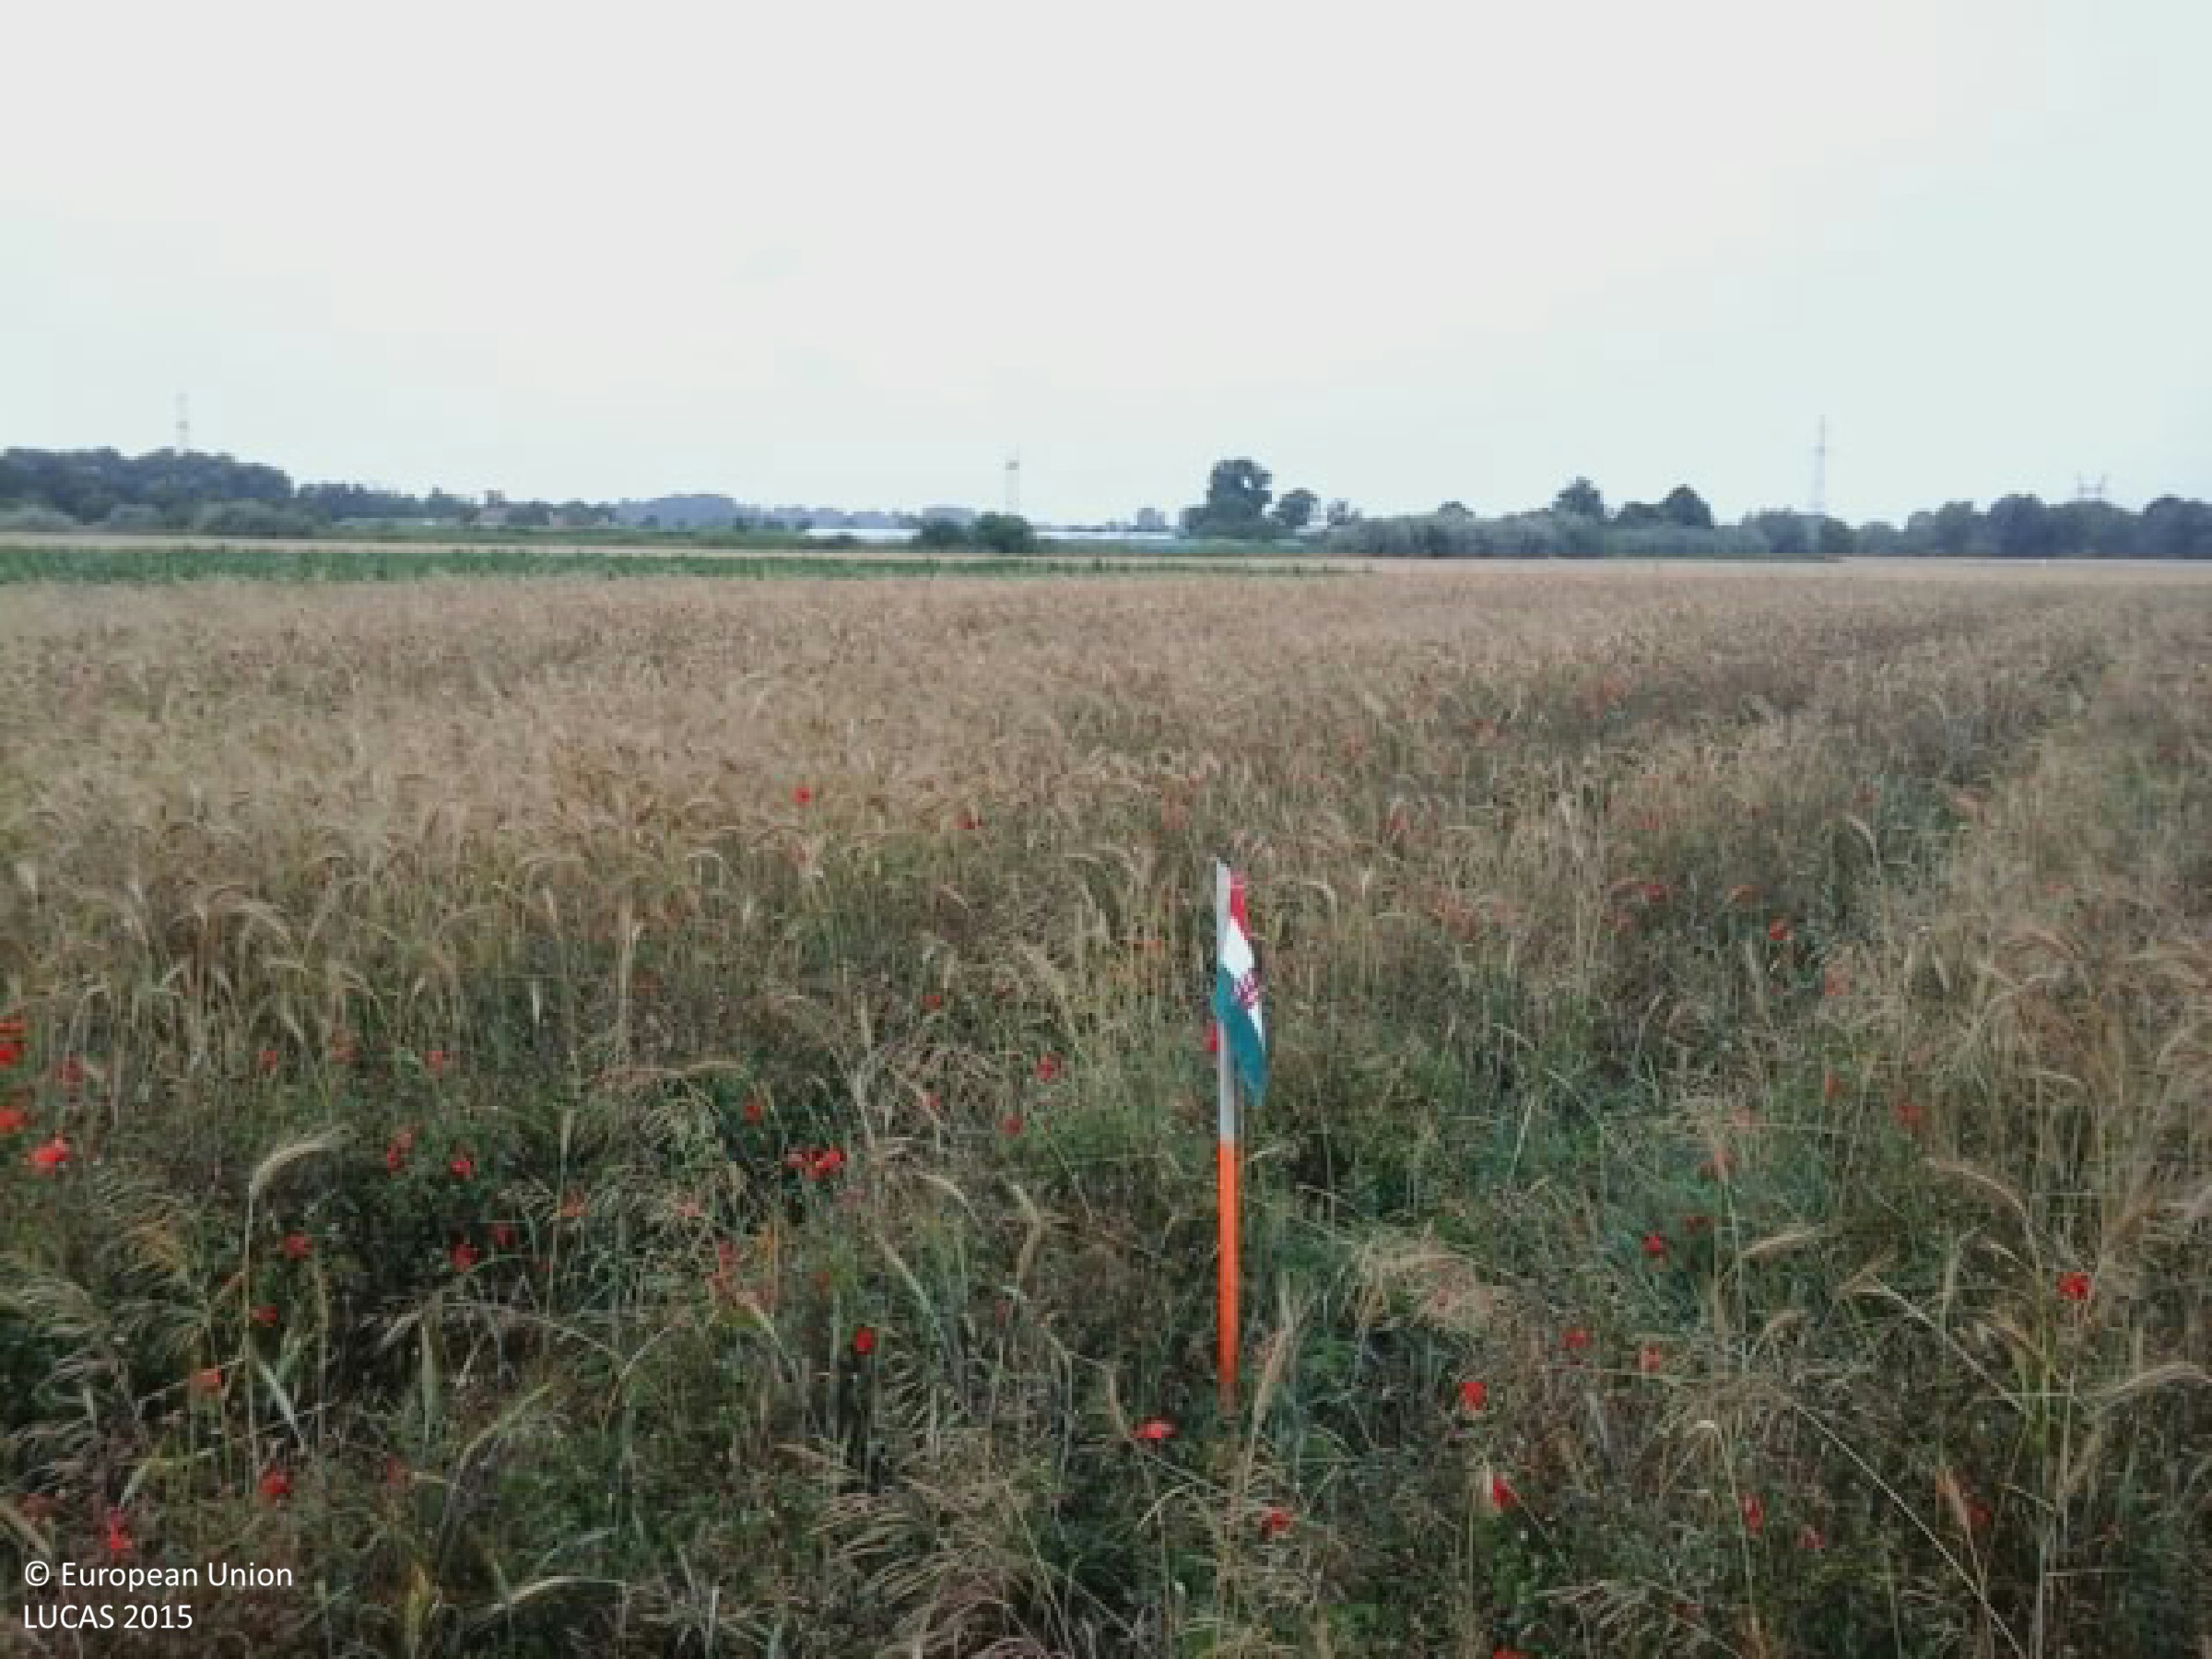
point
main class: Cropland
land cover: Common wheat
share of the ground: > 75 %
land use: Agriculture (excluding fallow land and kitchen gardens)
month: June
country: HU
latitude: 46.3980
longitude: 20.1018
